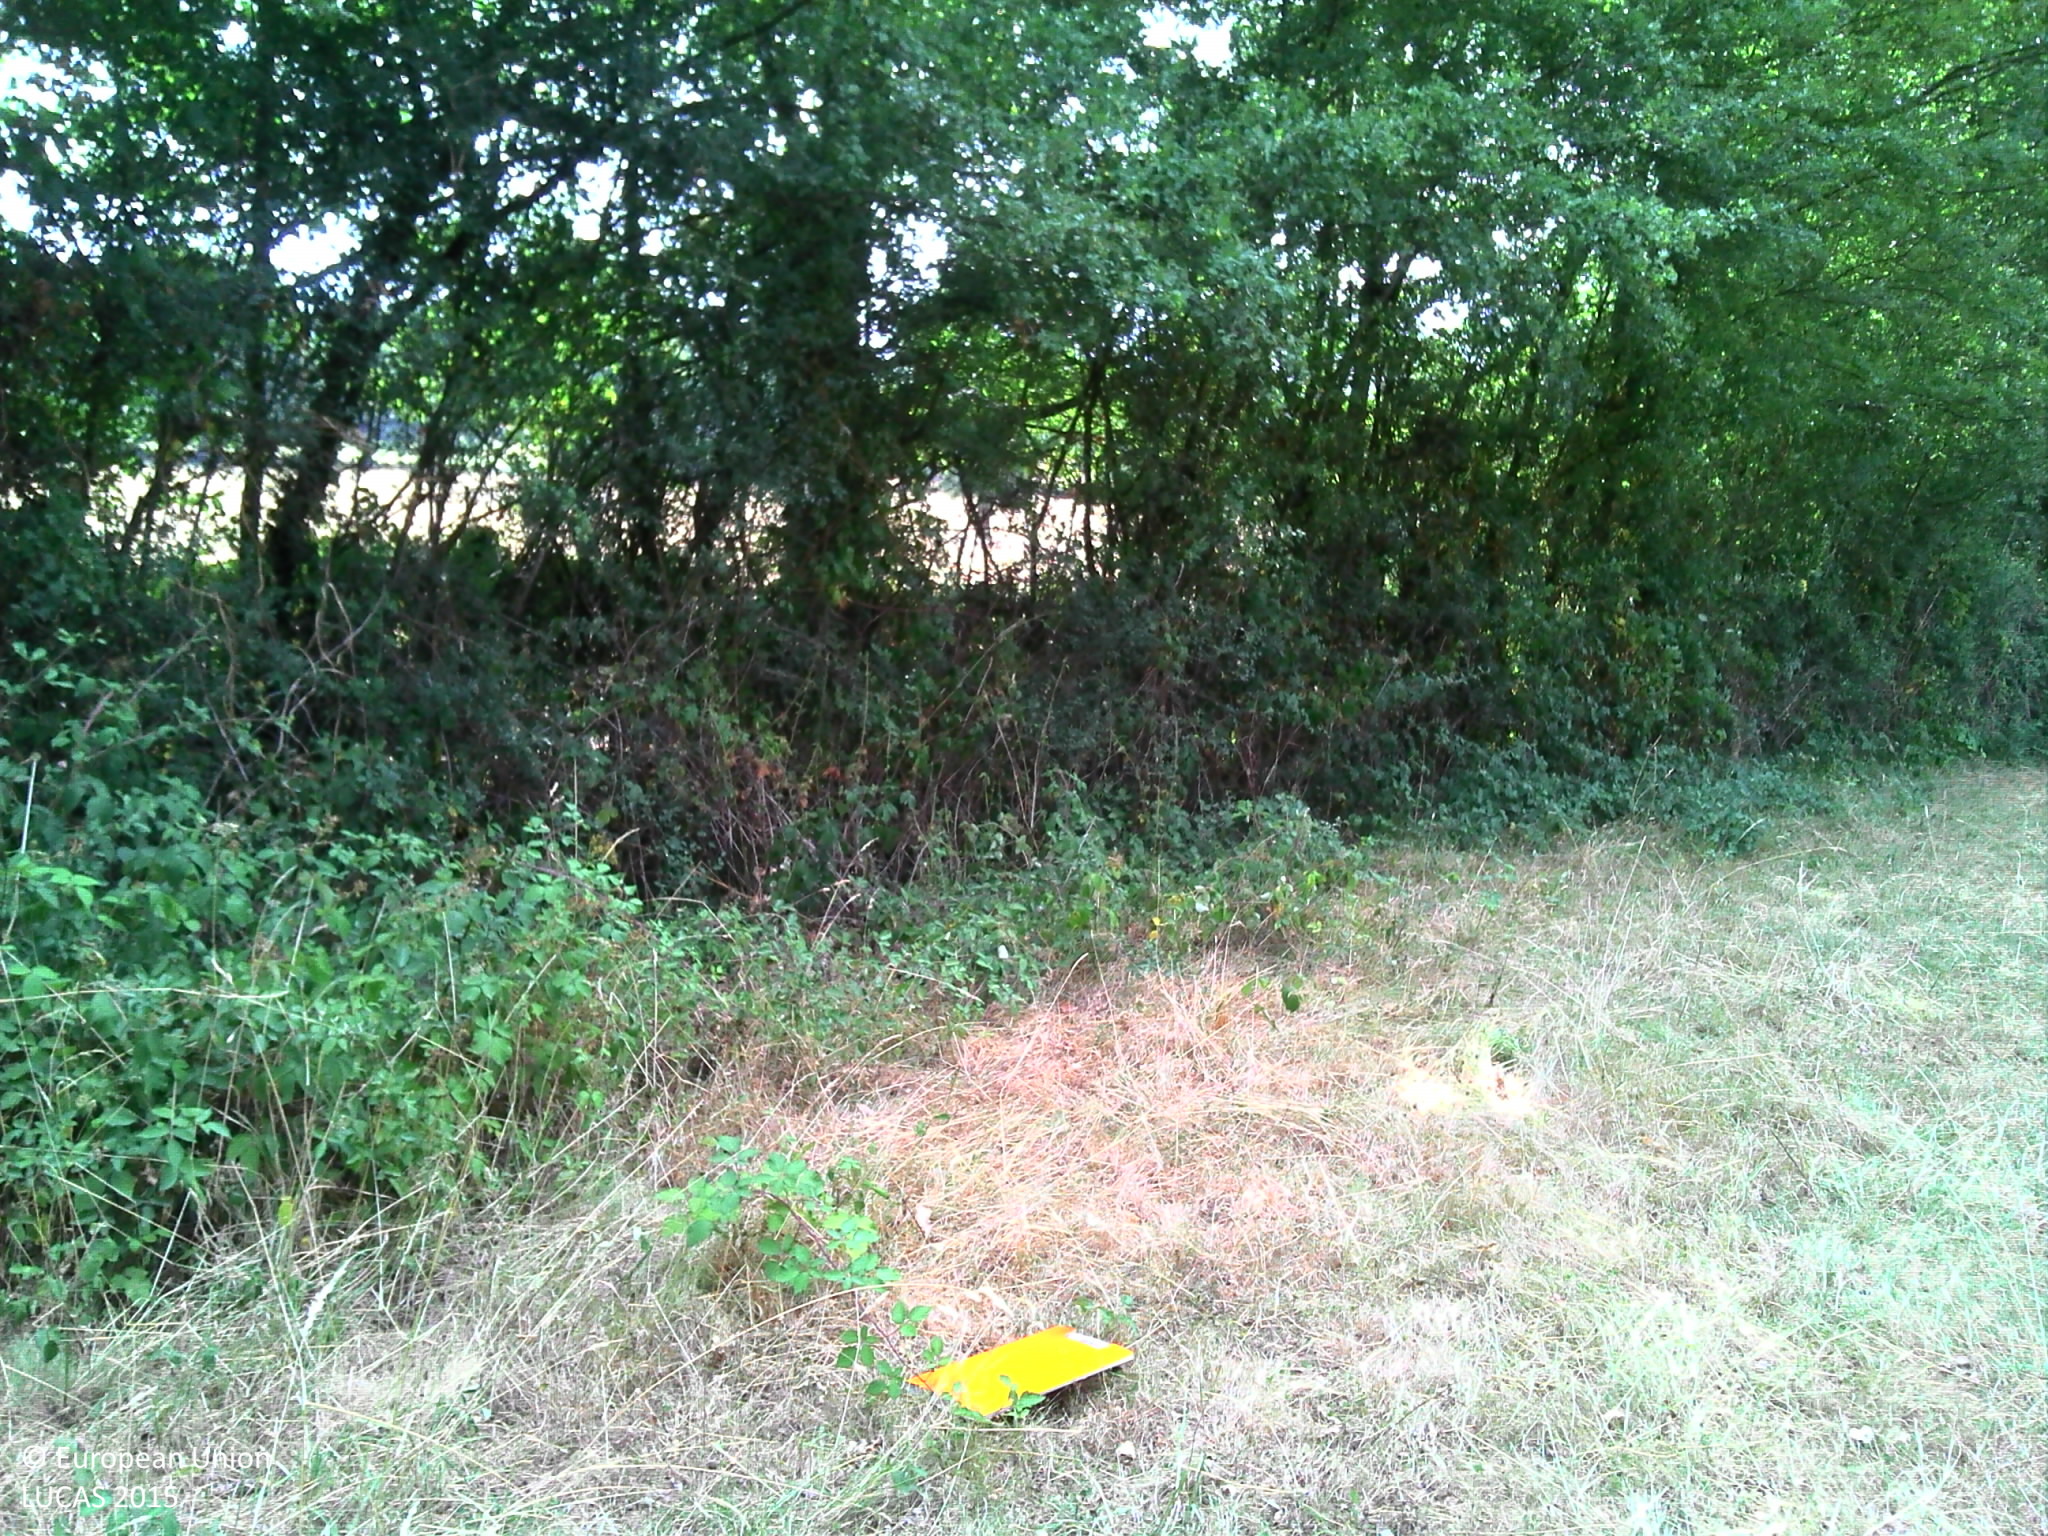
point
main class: Grassland
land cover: Grassland with sparse tree/shrub cover
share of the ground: > 75 %
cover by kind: herbaceous plants 85 %, shrubs 10 %, broadleaved forest trees 5 %
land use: Agriculture (excluding fallow land and kitchen gardens)
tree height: > 5 m
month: July
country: FR
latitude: 46.6301
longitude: 3.0351
